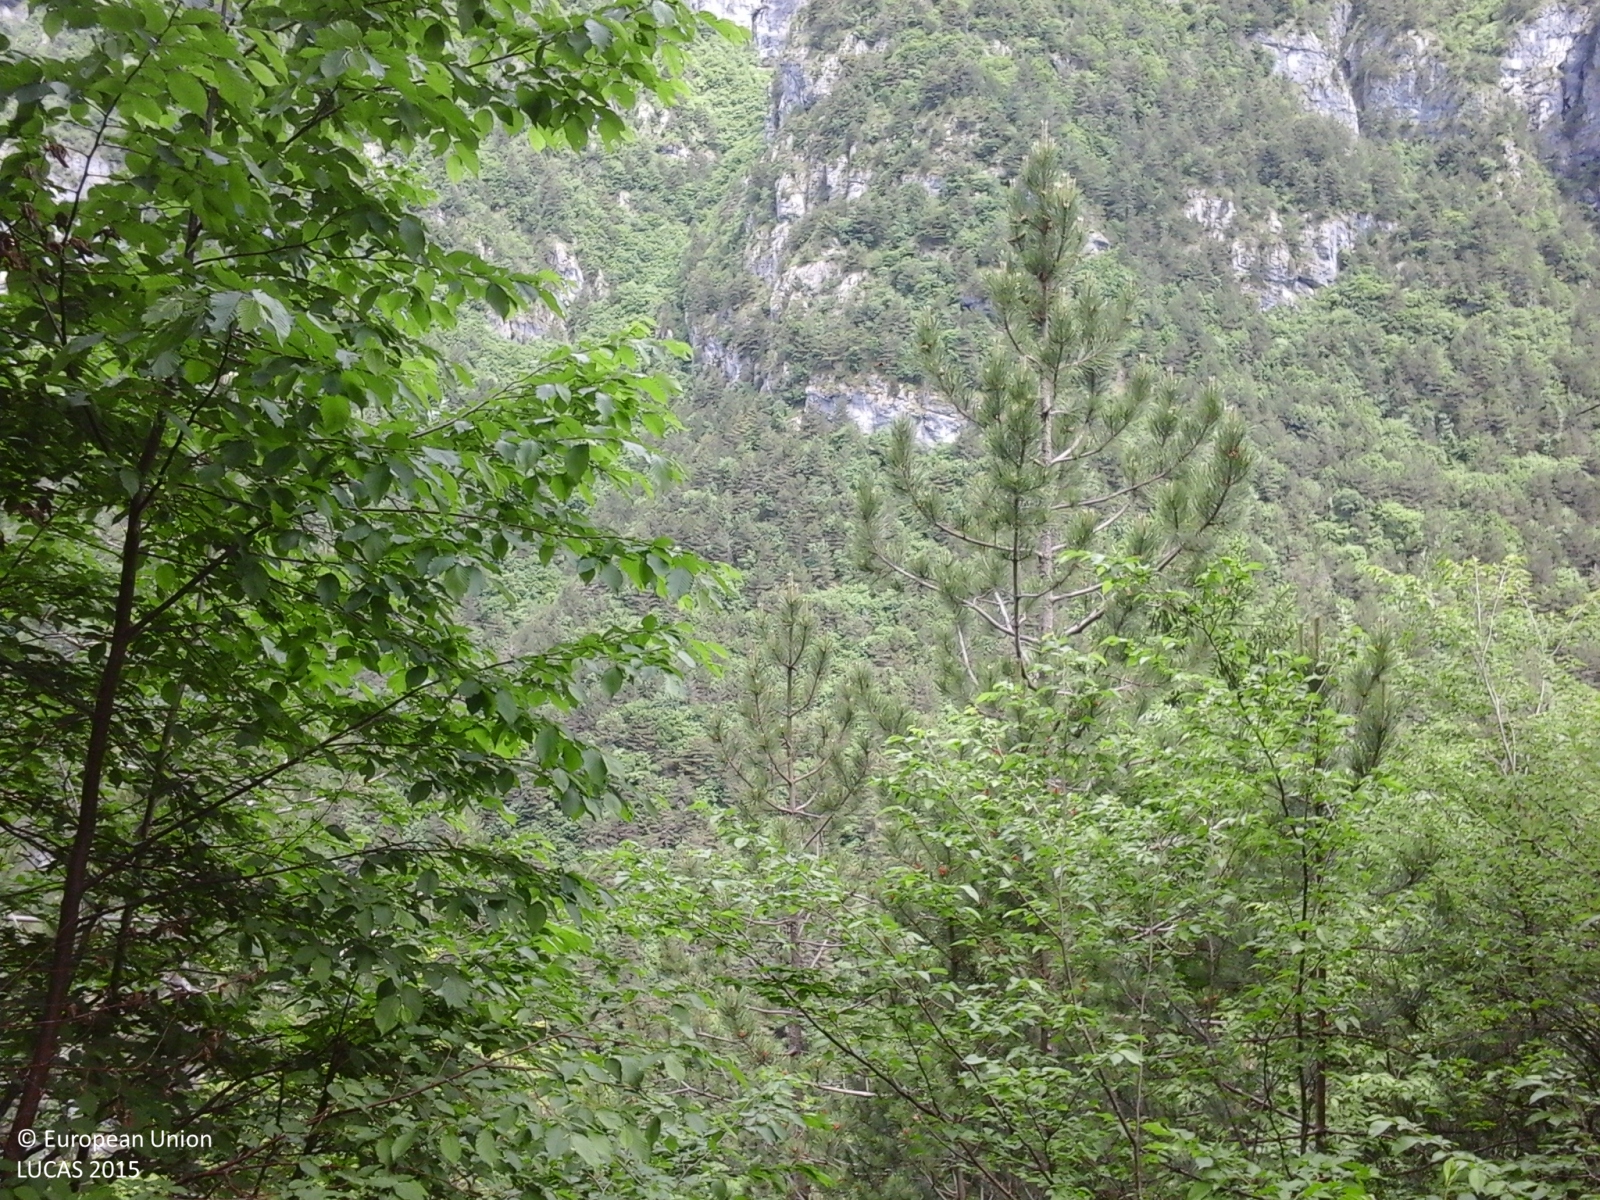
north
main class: Woodland
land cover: Other mixed woodland
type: mesophytic deciduous forest
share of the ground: > 75 %
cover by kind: broadleaved forest trees 60 %, coniferous forest trees 30 %, shrubs 10 %
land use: Semi-natural and natural areas not in use
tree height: > 5 m
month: June
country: IT
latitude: 46.2180
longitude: 12.3176
